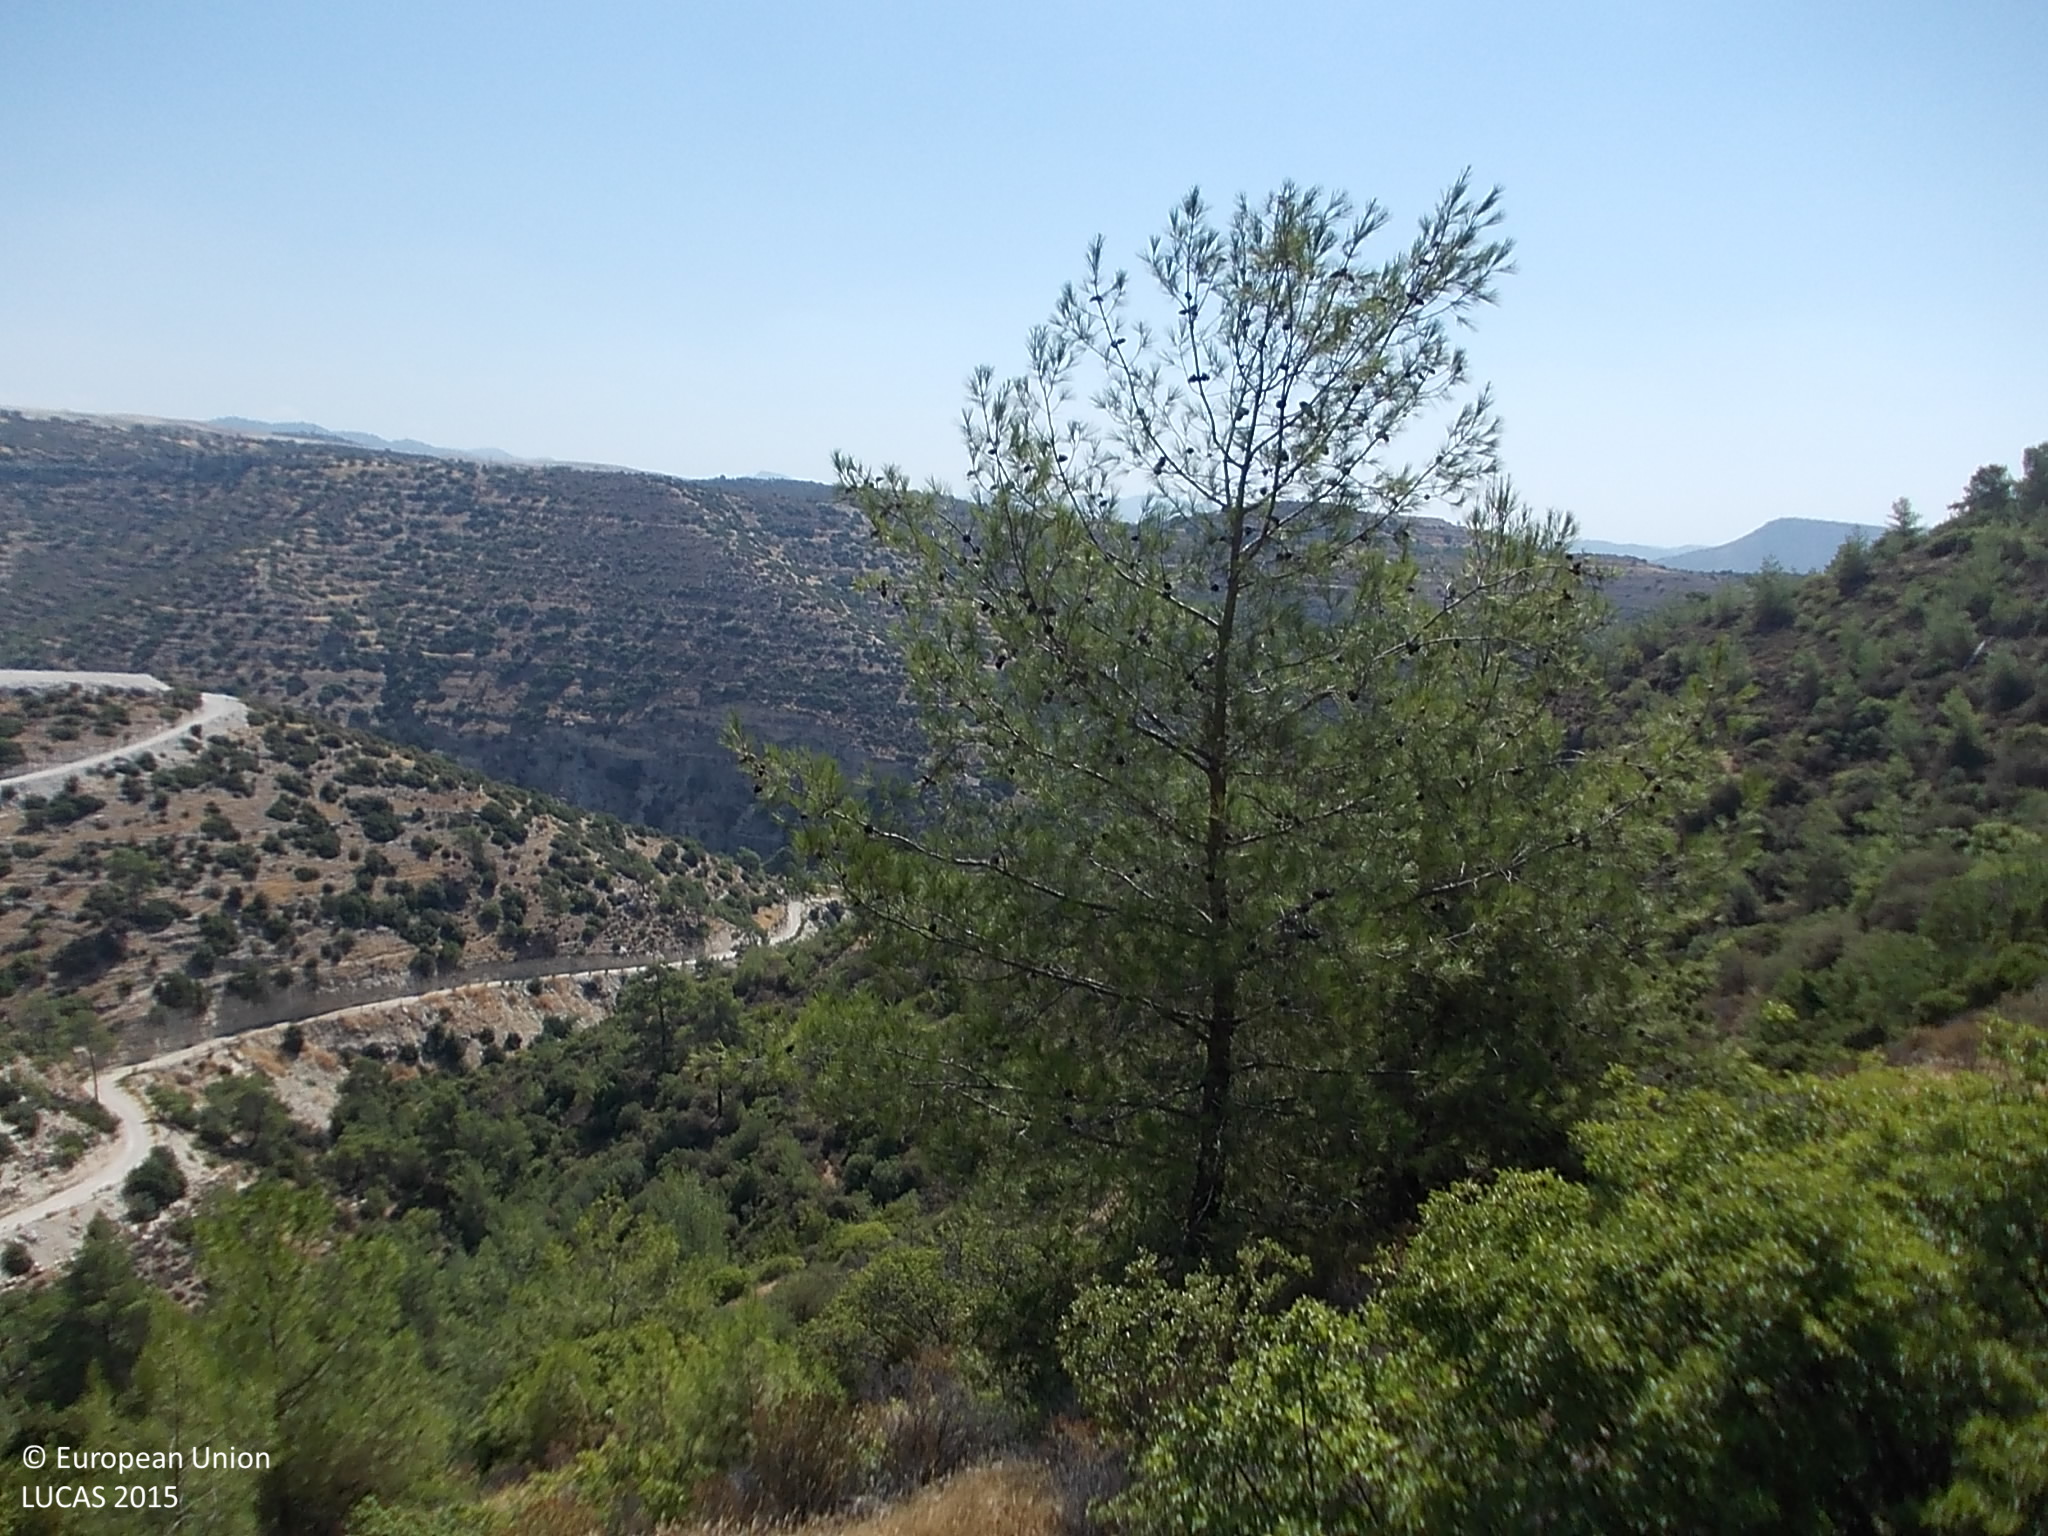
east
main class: Shrubland
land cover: Shrubland with sparse tree cover
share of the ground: > 75 %
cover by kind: shrubs 90 %, coniferous forest trees 5 %, unconsolidated bare surface 5 %
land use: Semi-natural and natural areas not in use
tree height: > 5 m
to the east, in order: Shrubland with sparse tree cover; Pine dominated coniferous woodland; Rivers and streams; Pine dominated coniferous woodland; Shrubland with sparse tree cover
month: August
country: CY
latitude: 34.7811
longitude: 32.9034
